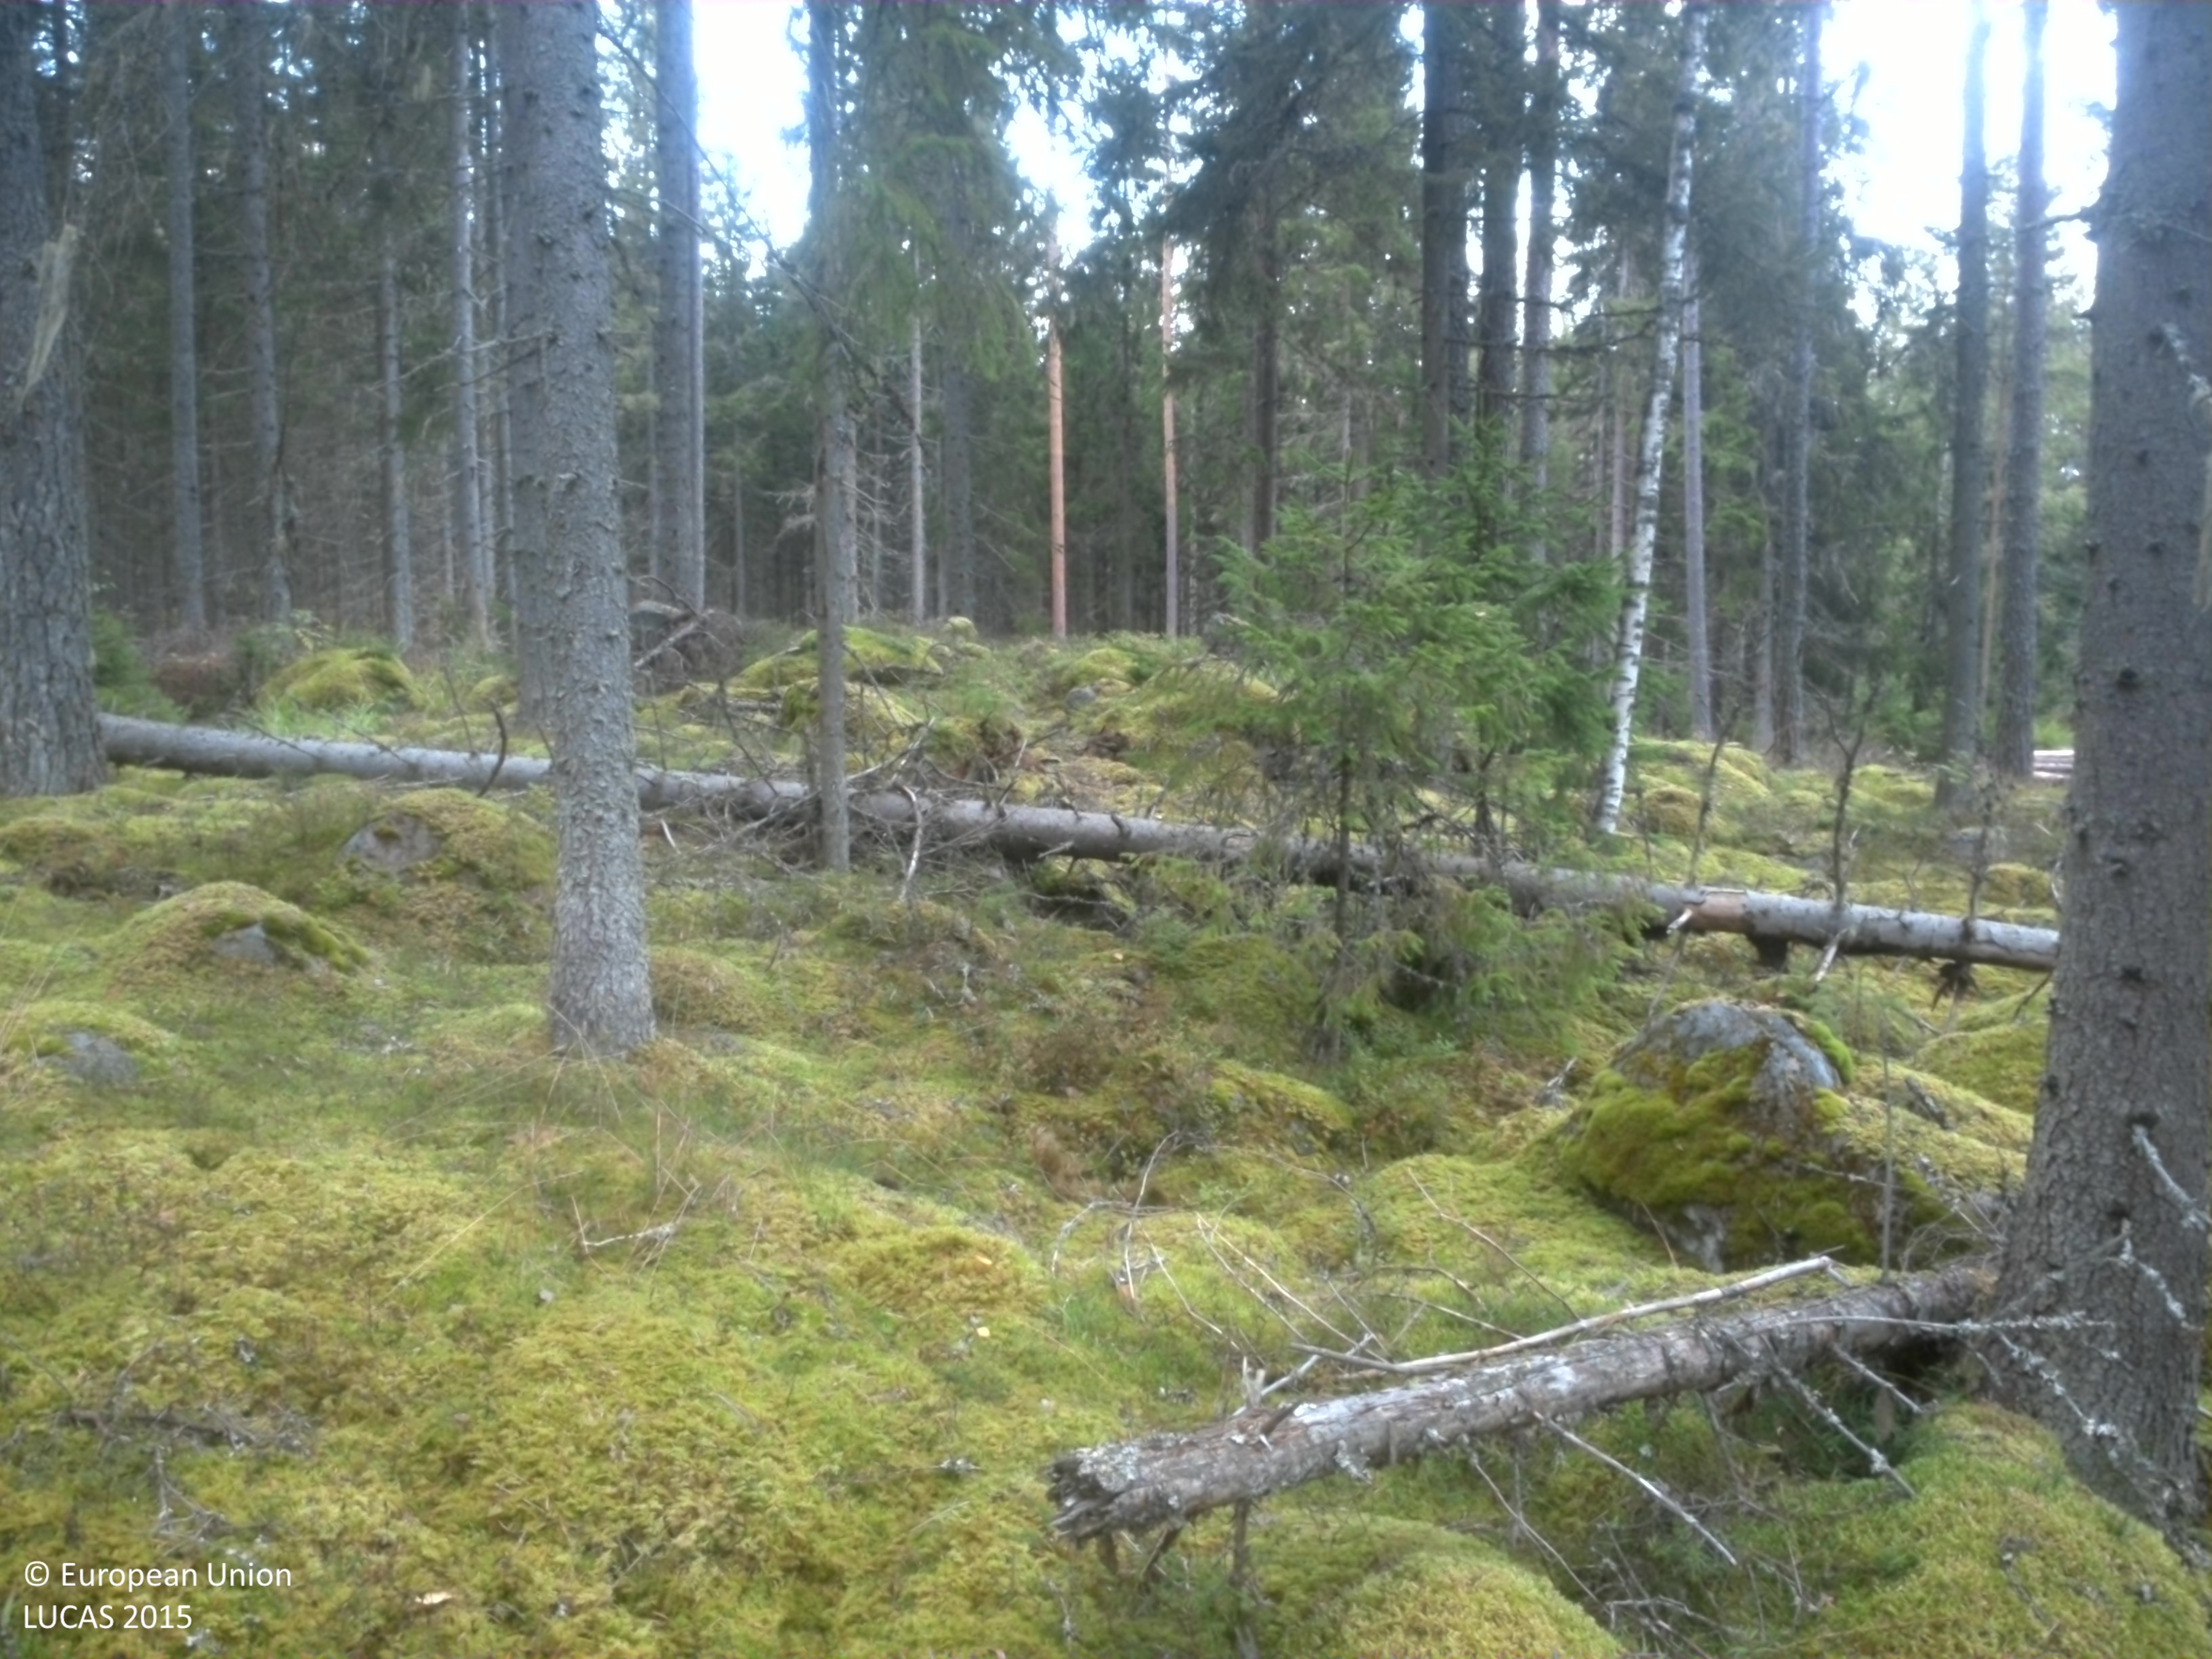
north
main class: Woodland
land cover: Spruce dominated coniferous woodland
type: boreal forest
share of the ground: 50 - 75 %
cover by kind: coniferous forest trees 60 %, lichens and mosses 25 %, herbaceous plants 10 %, shrubs 5 %
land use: Forestry
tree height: > 5 m
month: September
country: SE
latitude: 59.6165
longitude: 15.6452
